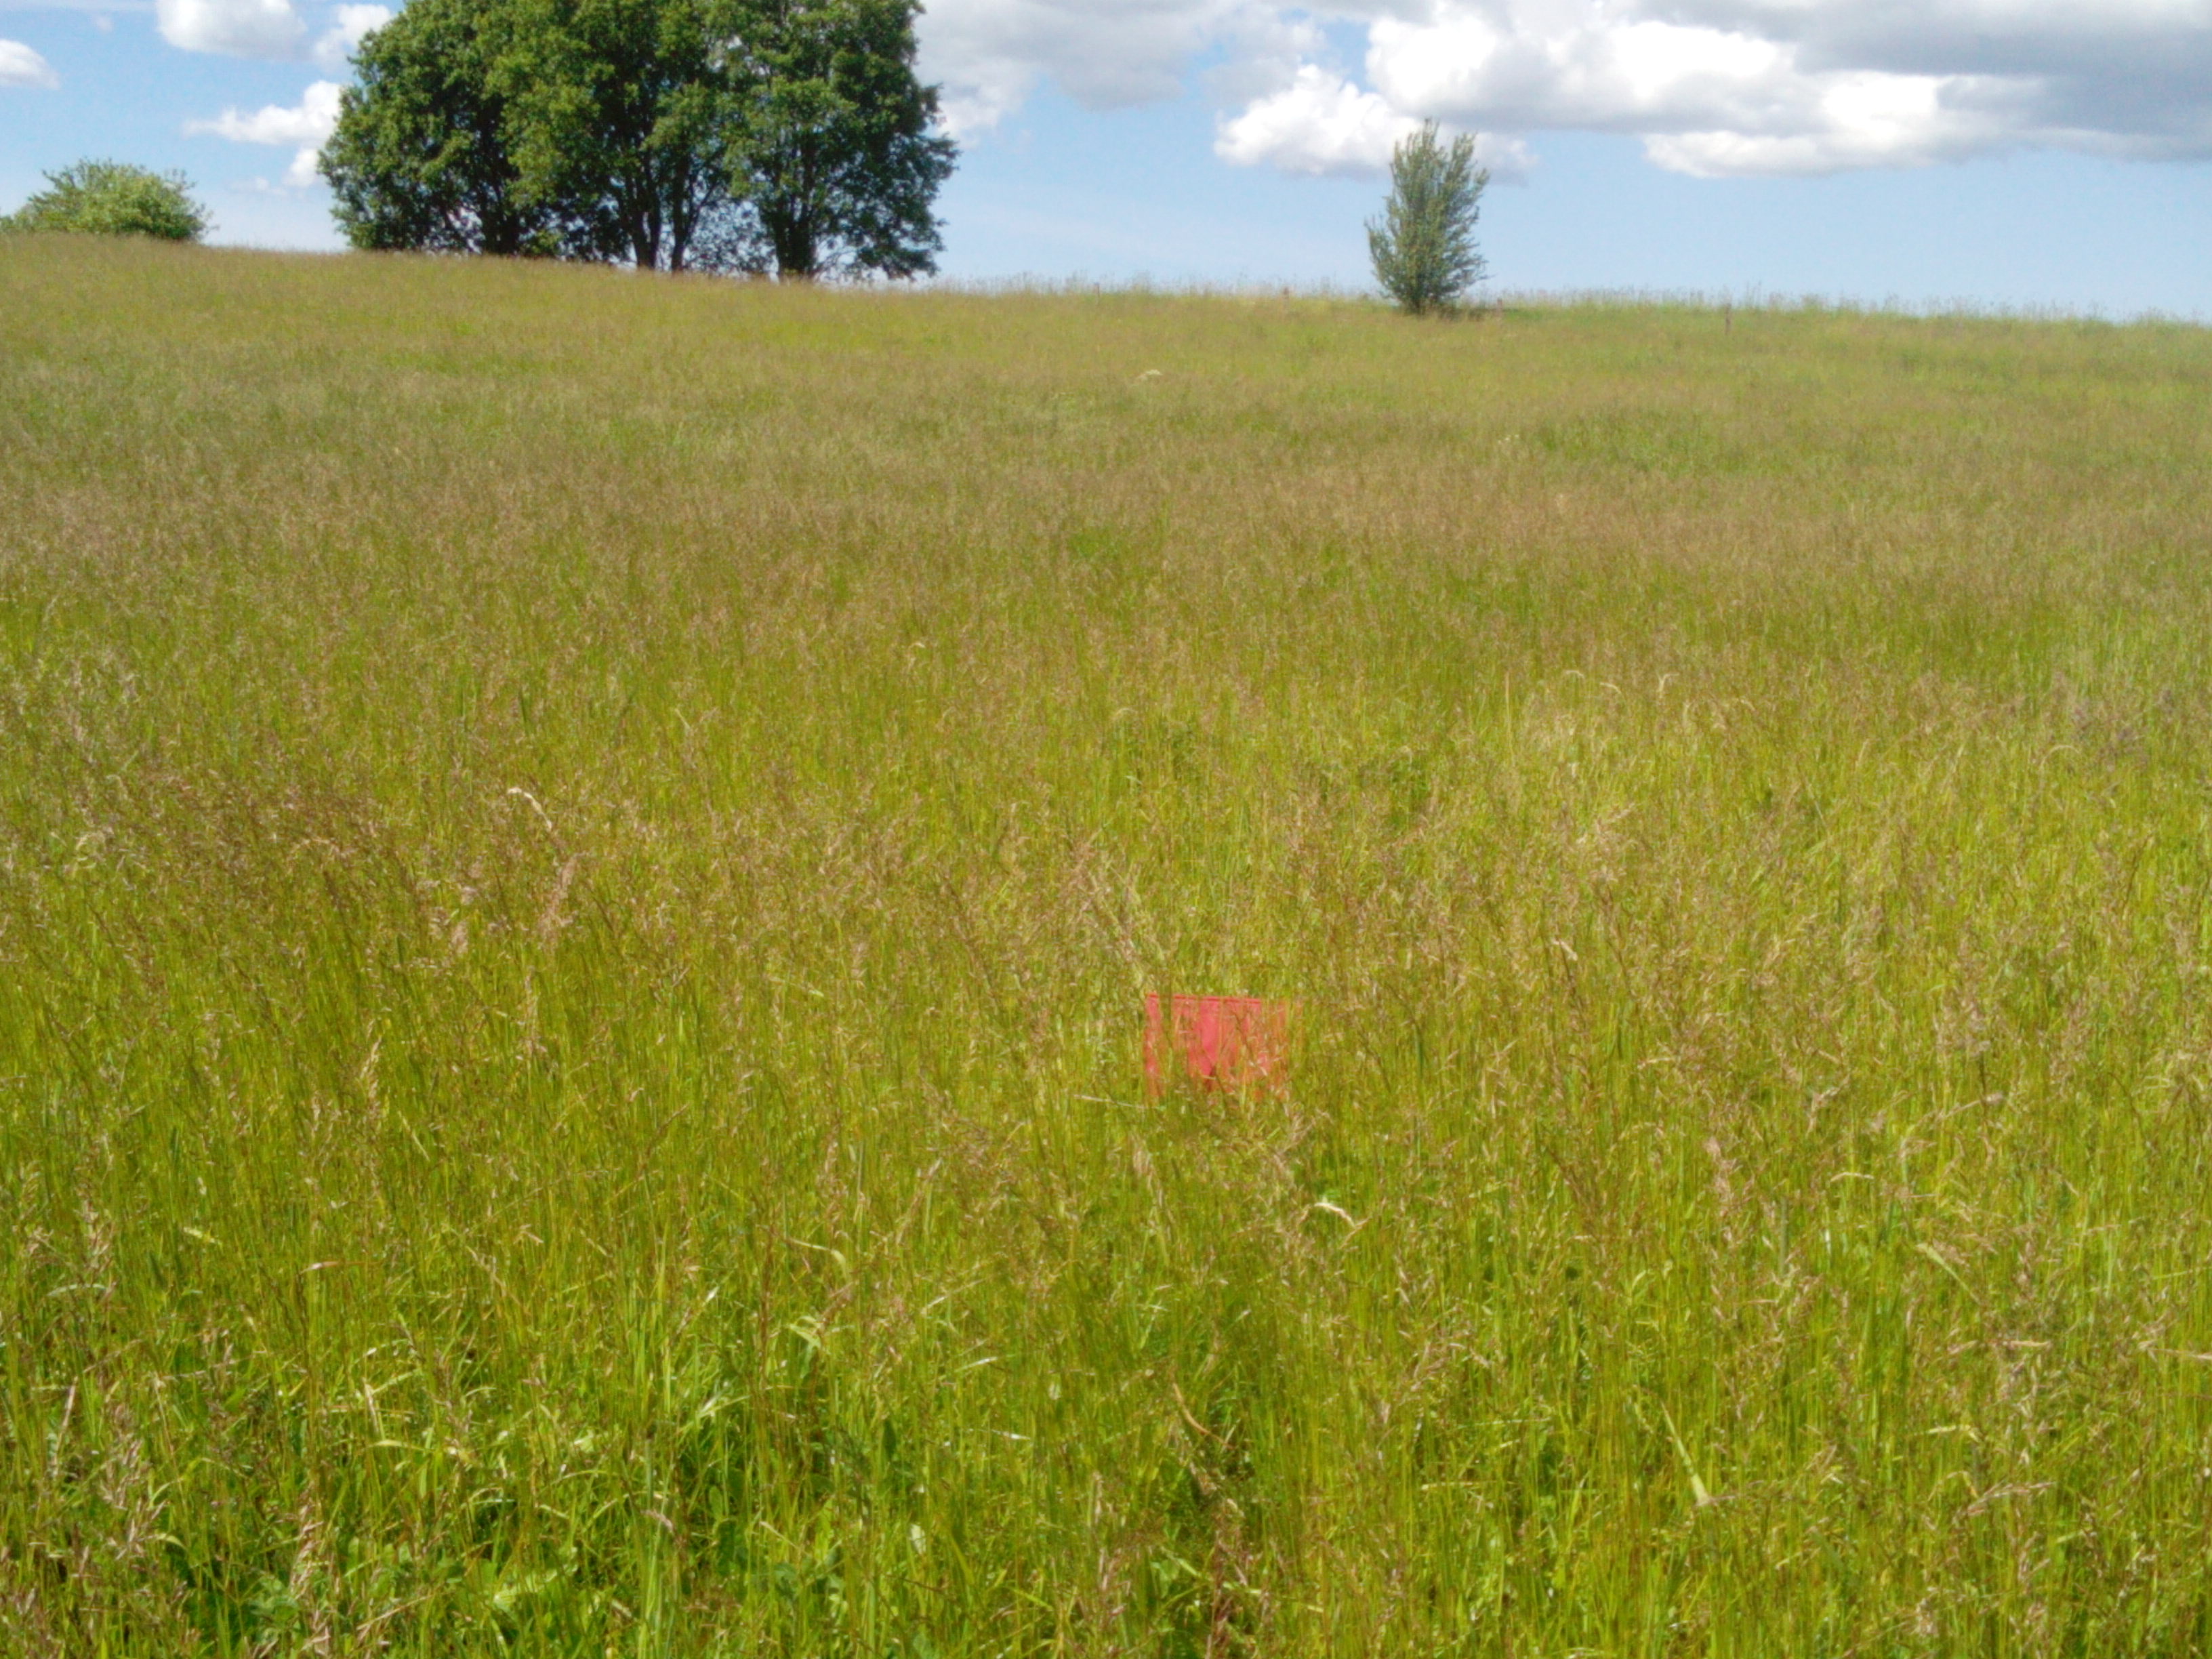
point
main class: Grassland
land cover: Grassland without tree/shrub cover
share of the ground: > 75 %
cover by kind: herbaceous plants 100 %
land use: Agriculture (excluding fallow land and kitchen gardens)
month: June
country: LV
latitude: 56.7919
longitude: 21.7501
